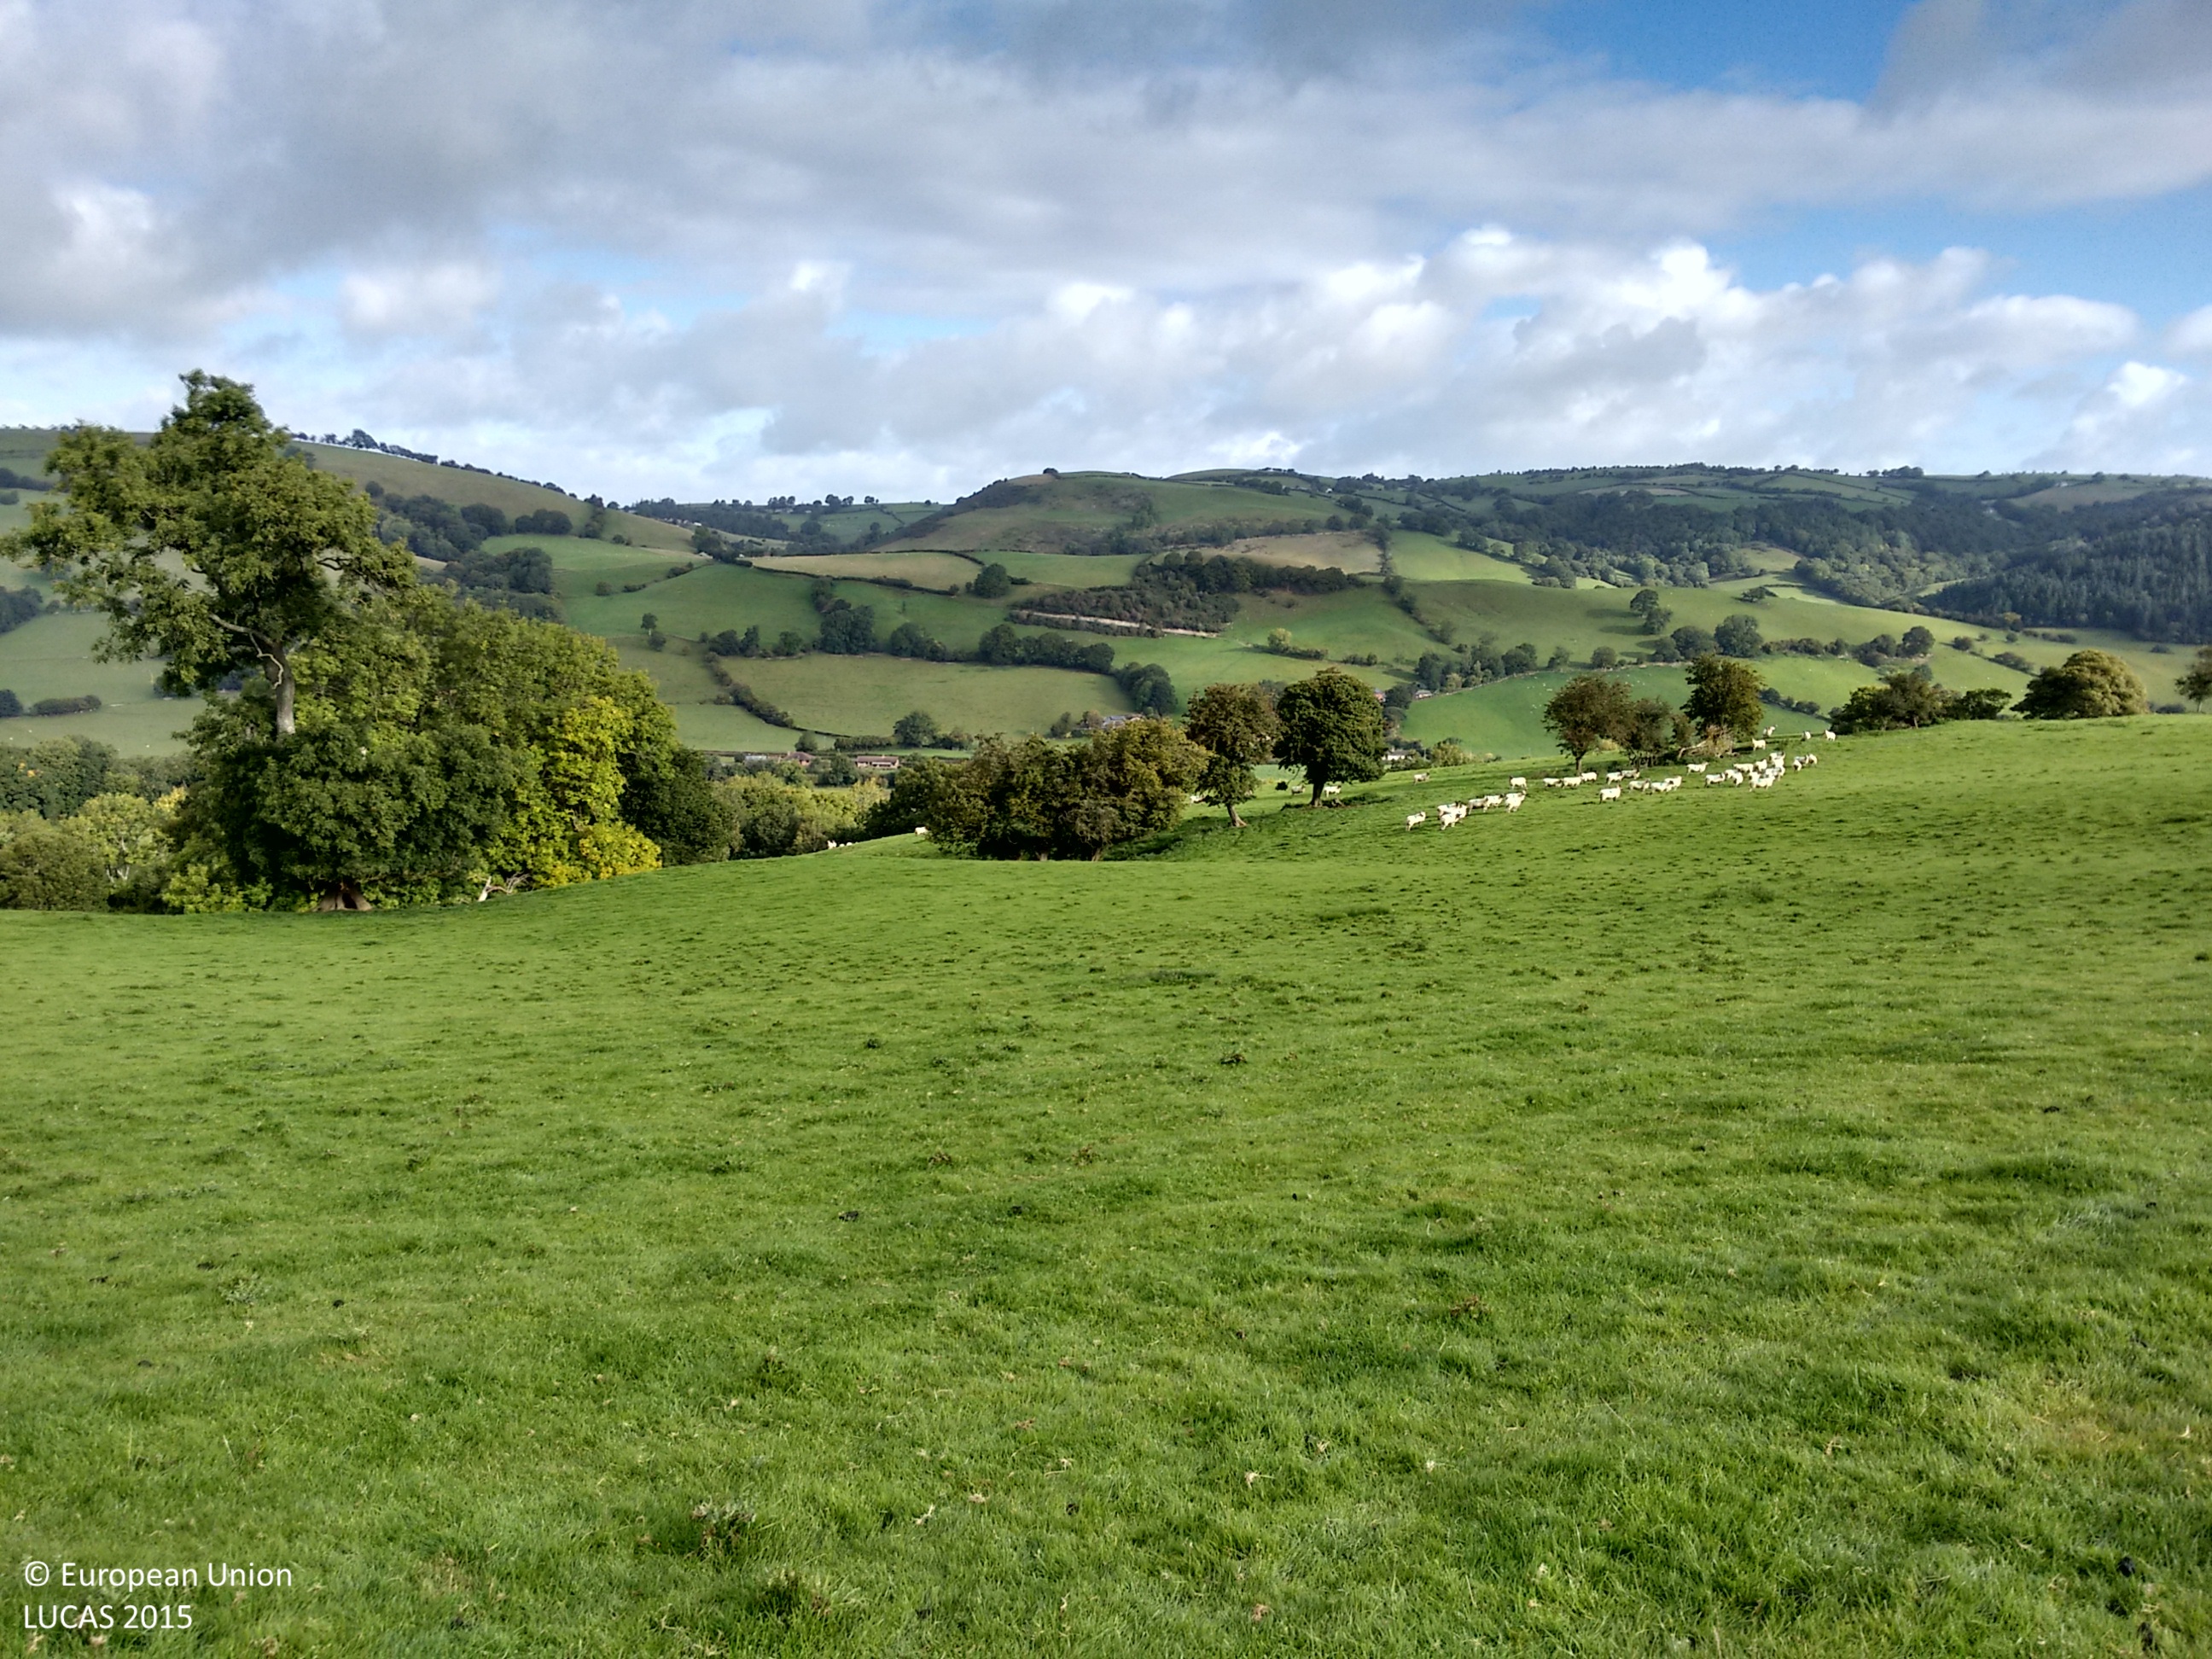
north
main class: Grassland
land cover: Grassland without tree/shrub cover
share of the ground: > 75 %
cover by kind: herbaceous plants 100 %
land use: Agriculture (excluding fallow land and kitchen gardens)
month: September
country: GB
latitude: 52.6096
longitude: -3.2974
